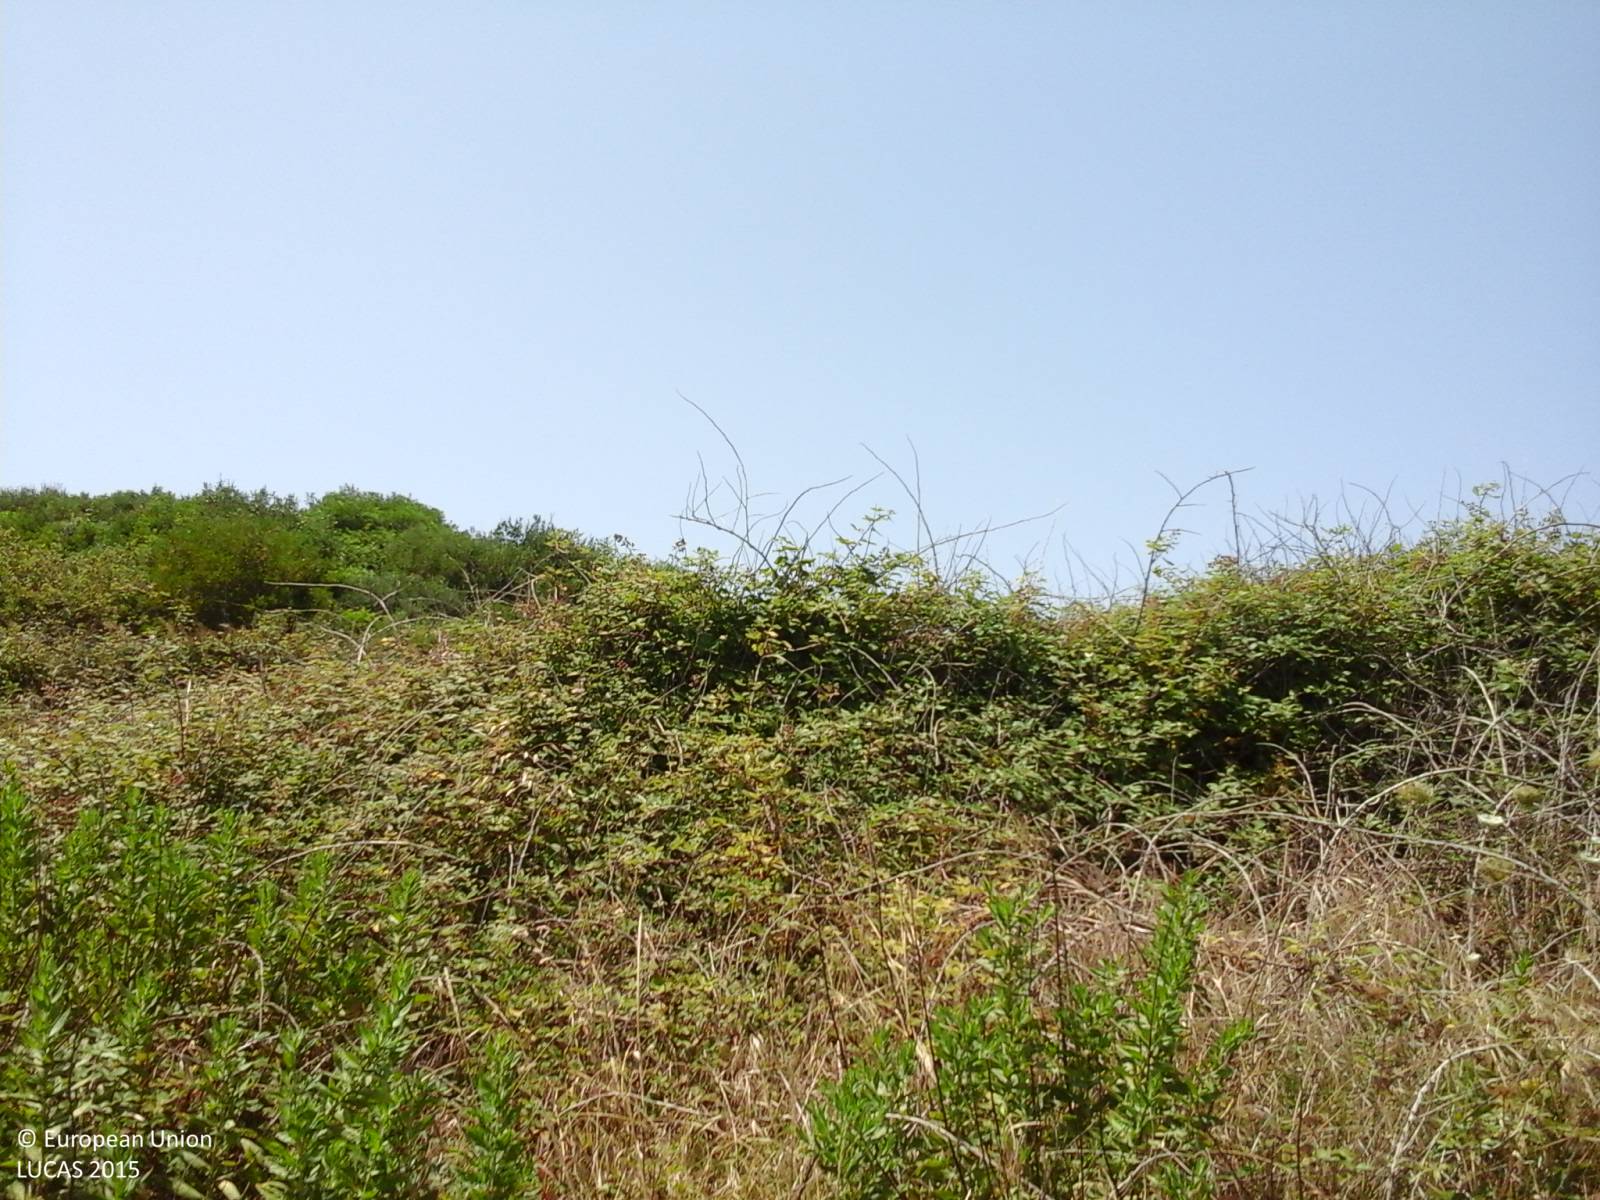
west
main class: Shrubland
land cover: Shrubland without tree cover
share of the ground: > 75 %
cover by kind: shrubs 100 %
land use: Semi-natural and natural areas not in use
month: July
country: IT
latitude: 39.9344
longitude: 8.8246
